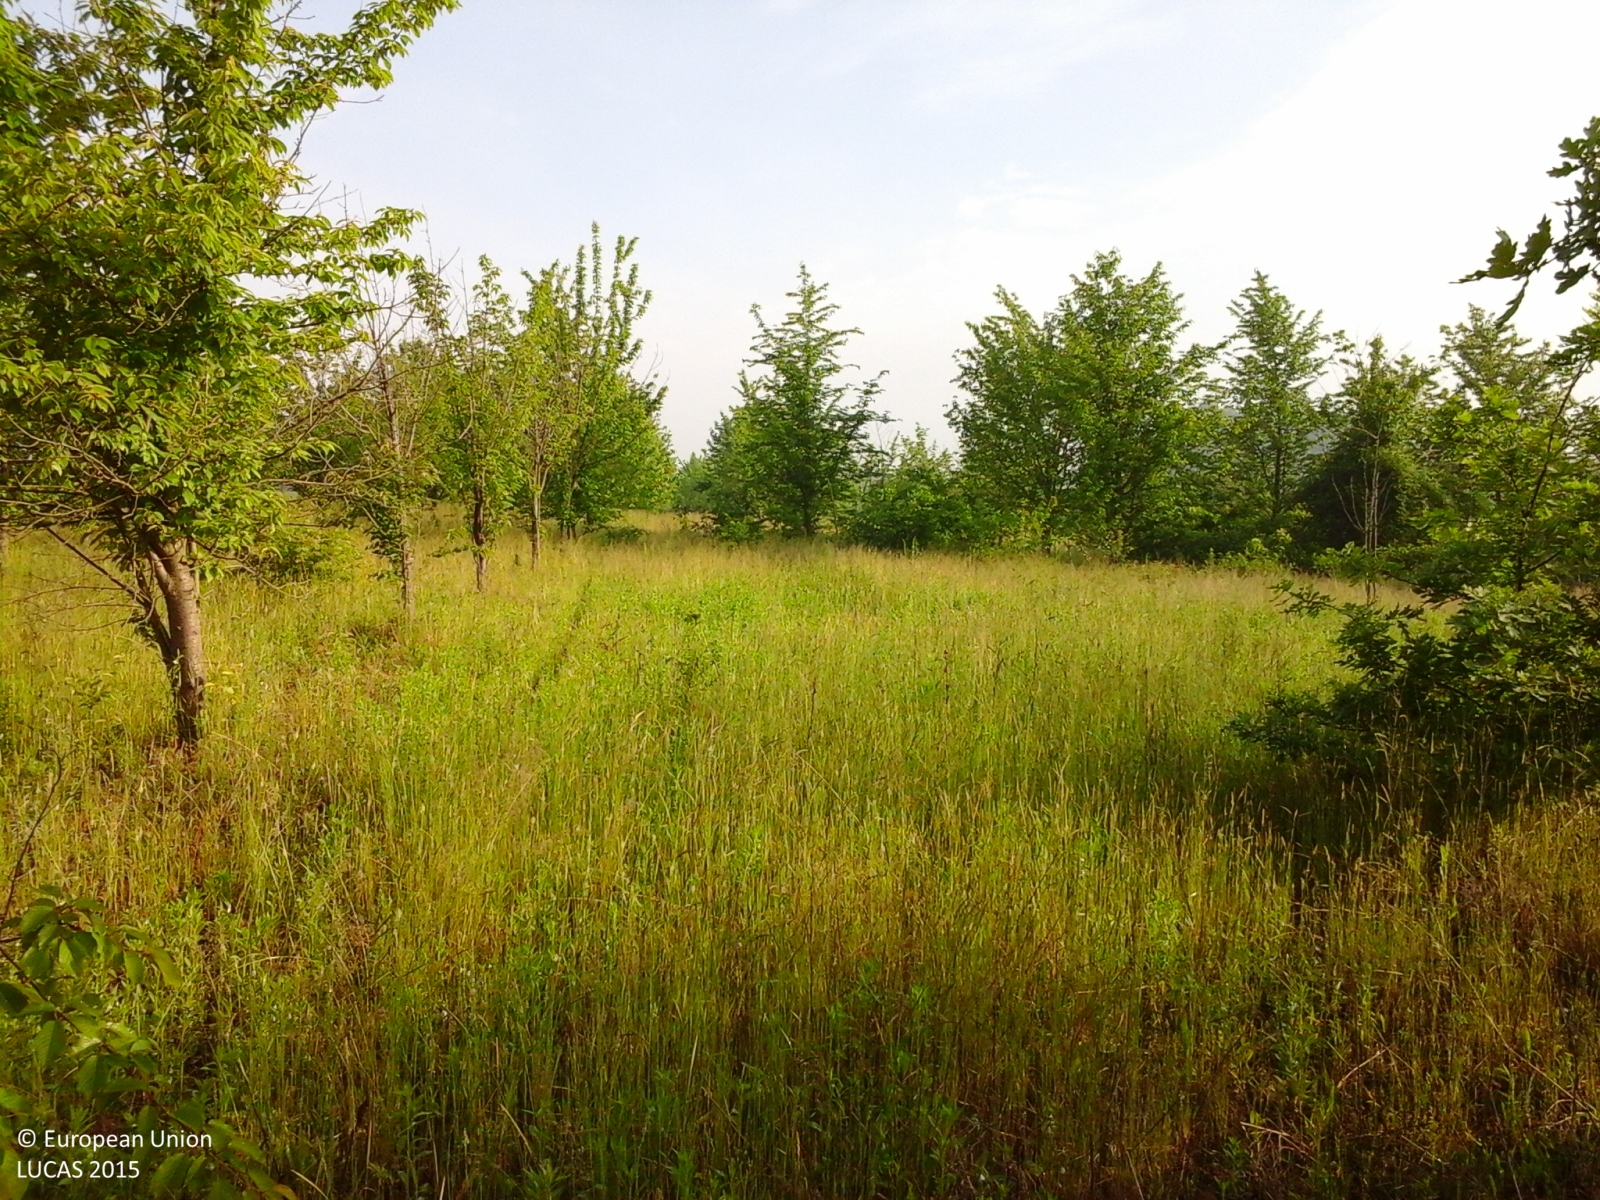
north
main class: Cropland
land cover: Cherry fruit
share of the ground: 10 - 25 %
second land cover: Spontaneously vegetated surfaces
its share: > 75 %
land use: Abandoned areas
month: May
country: IT
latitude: 44.9341
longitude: 8.4444
